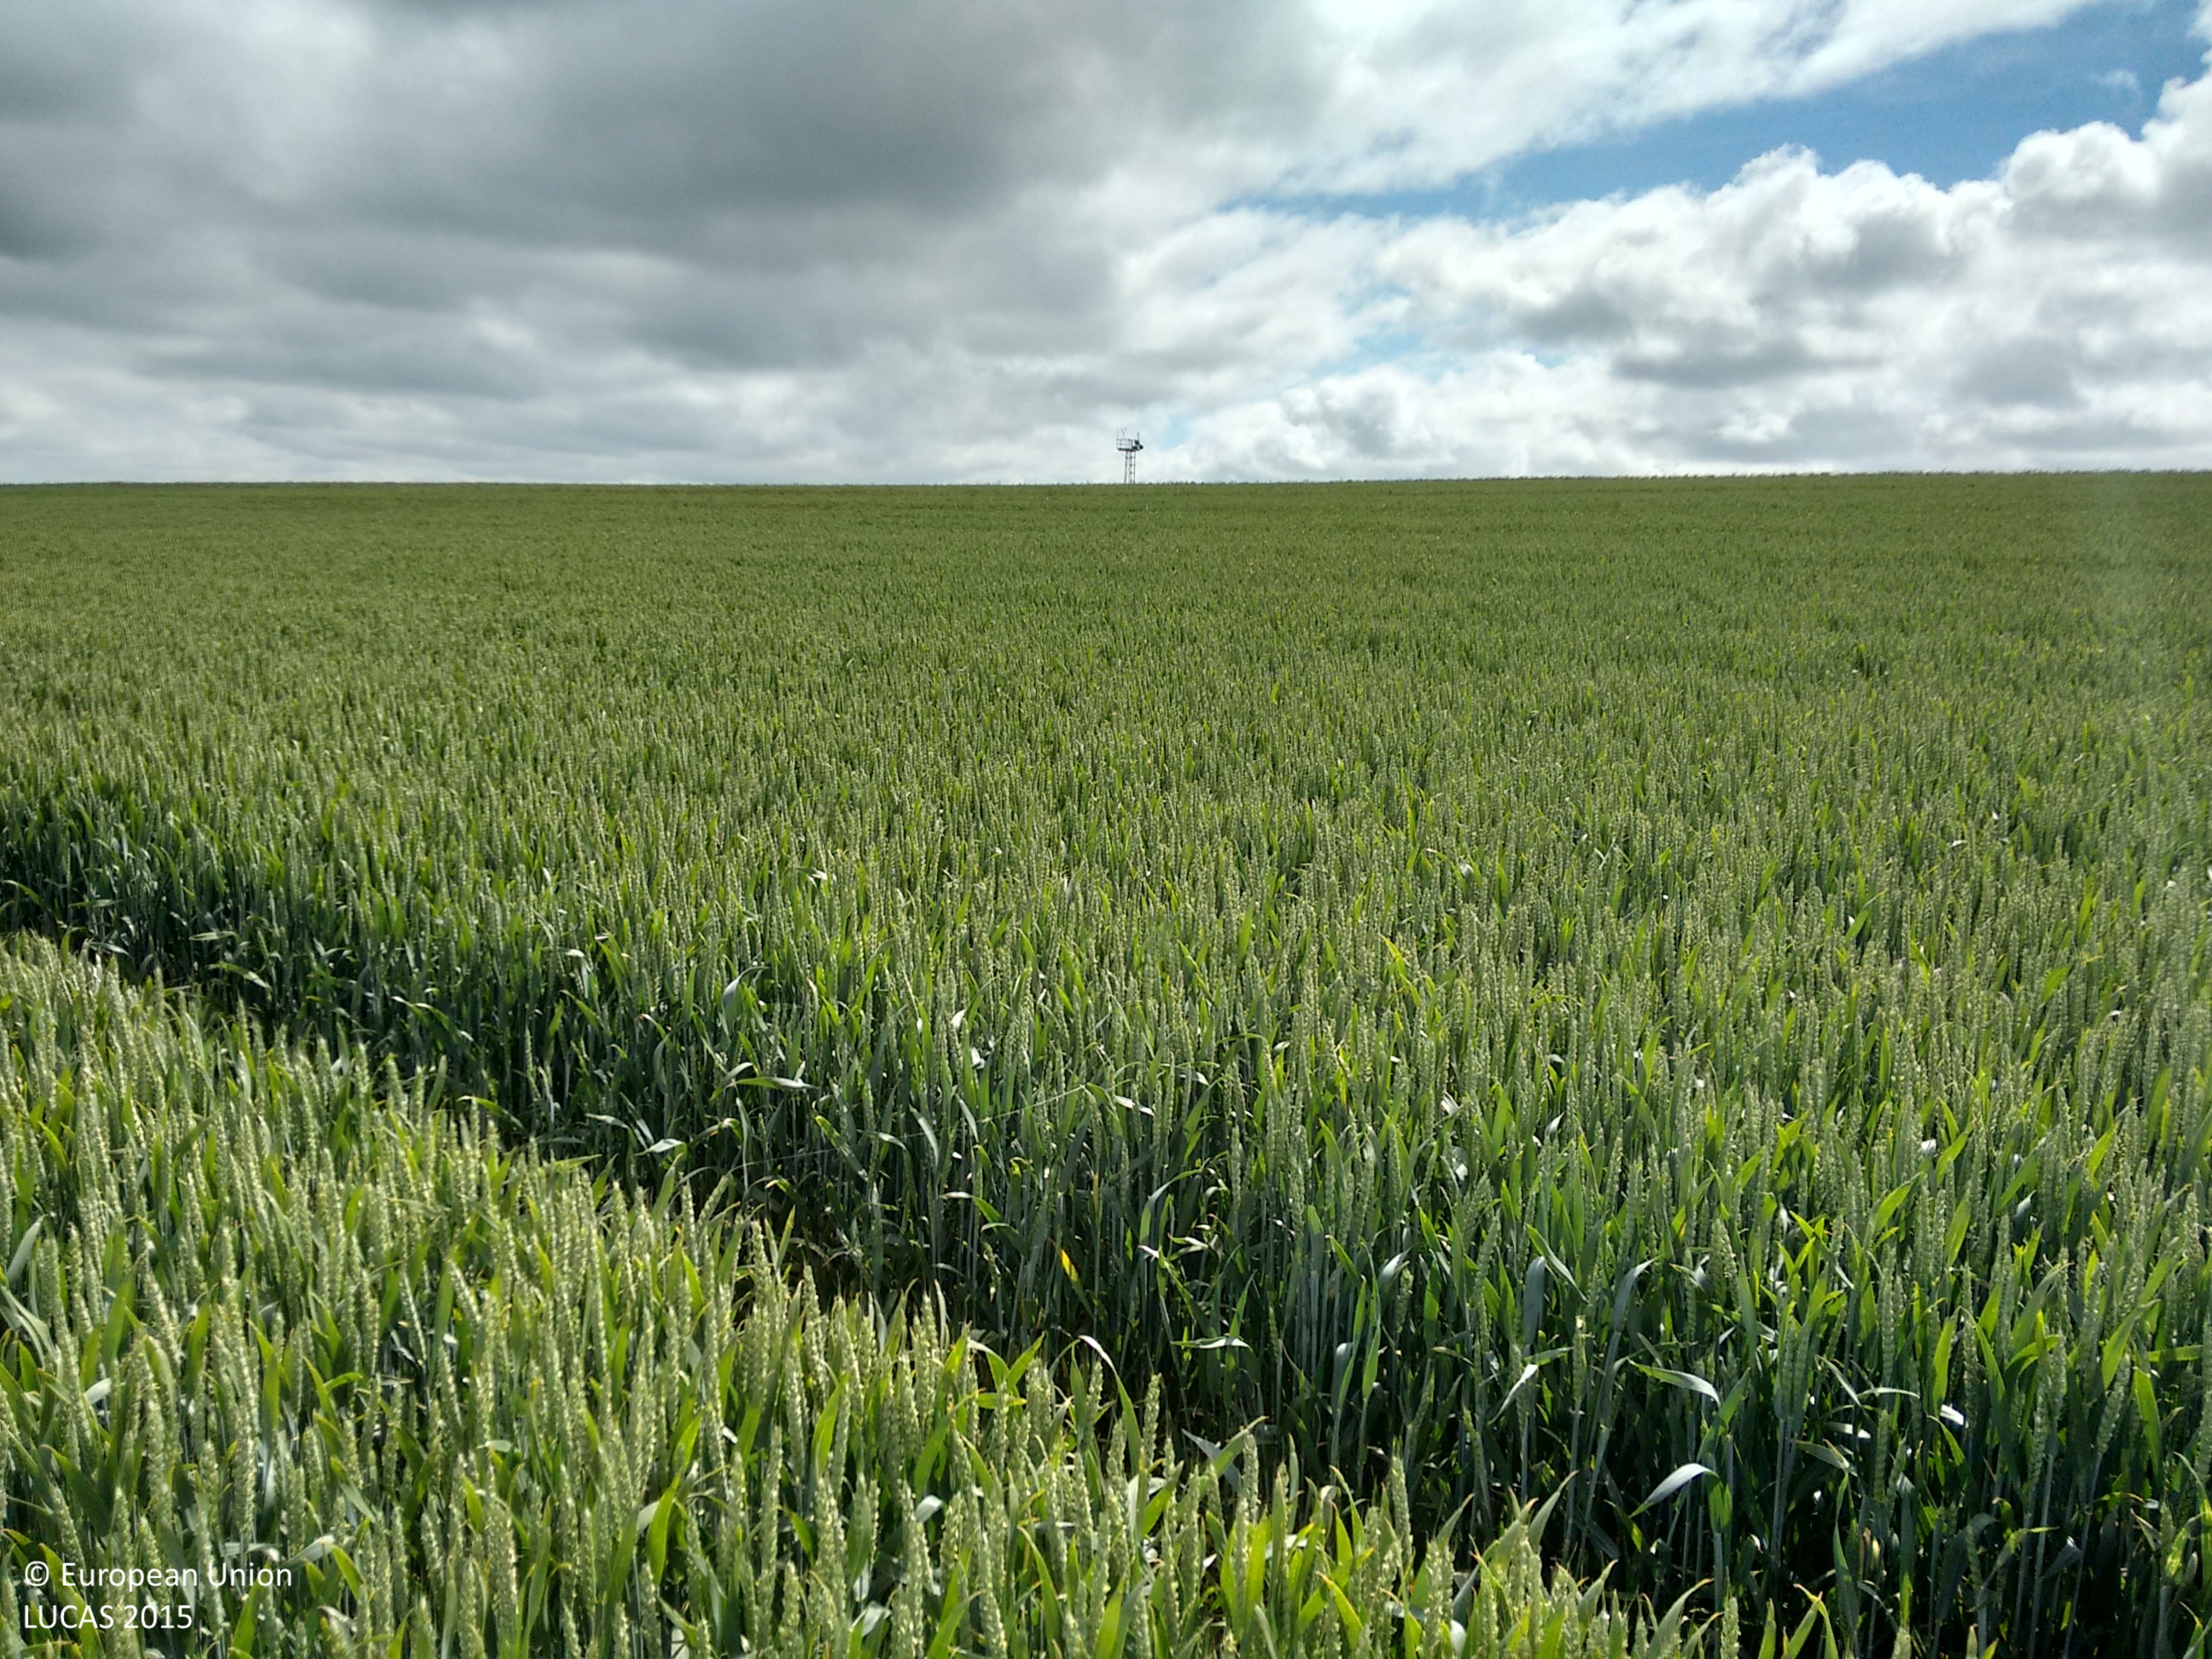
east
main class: Cropland
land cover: Common wheat
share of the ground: > 75 %
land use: Agriculture (excluding fallow land and kitchen gardens)
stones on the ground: 25 - 50 %
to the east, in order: Common wheat; Grassland without tree/shrub cover; Artificial constructions in urban areas; Grassland without tree/shrub cover; Paved roads, cycling and walking lanes
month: June
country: GB
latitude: 51.2781
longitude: -1.9711
